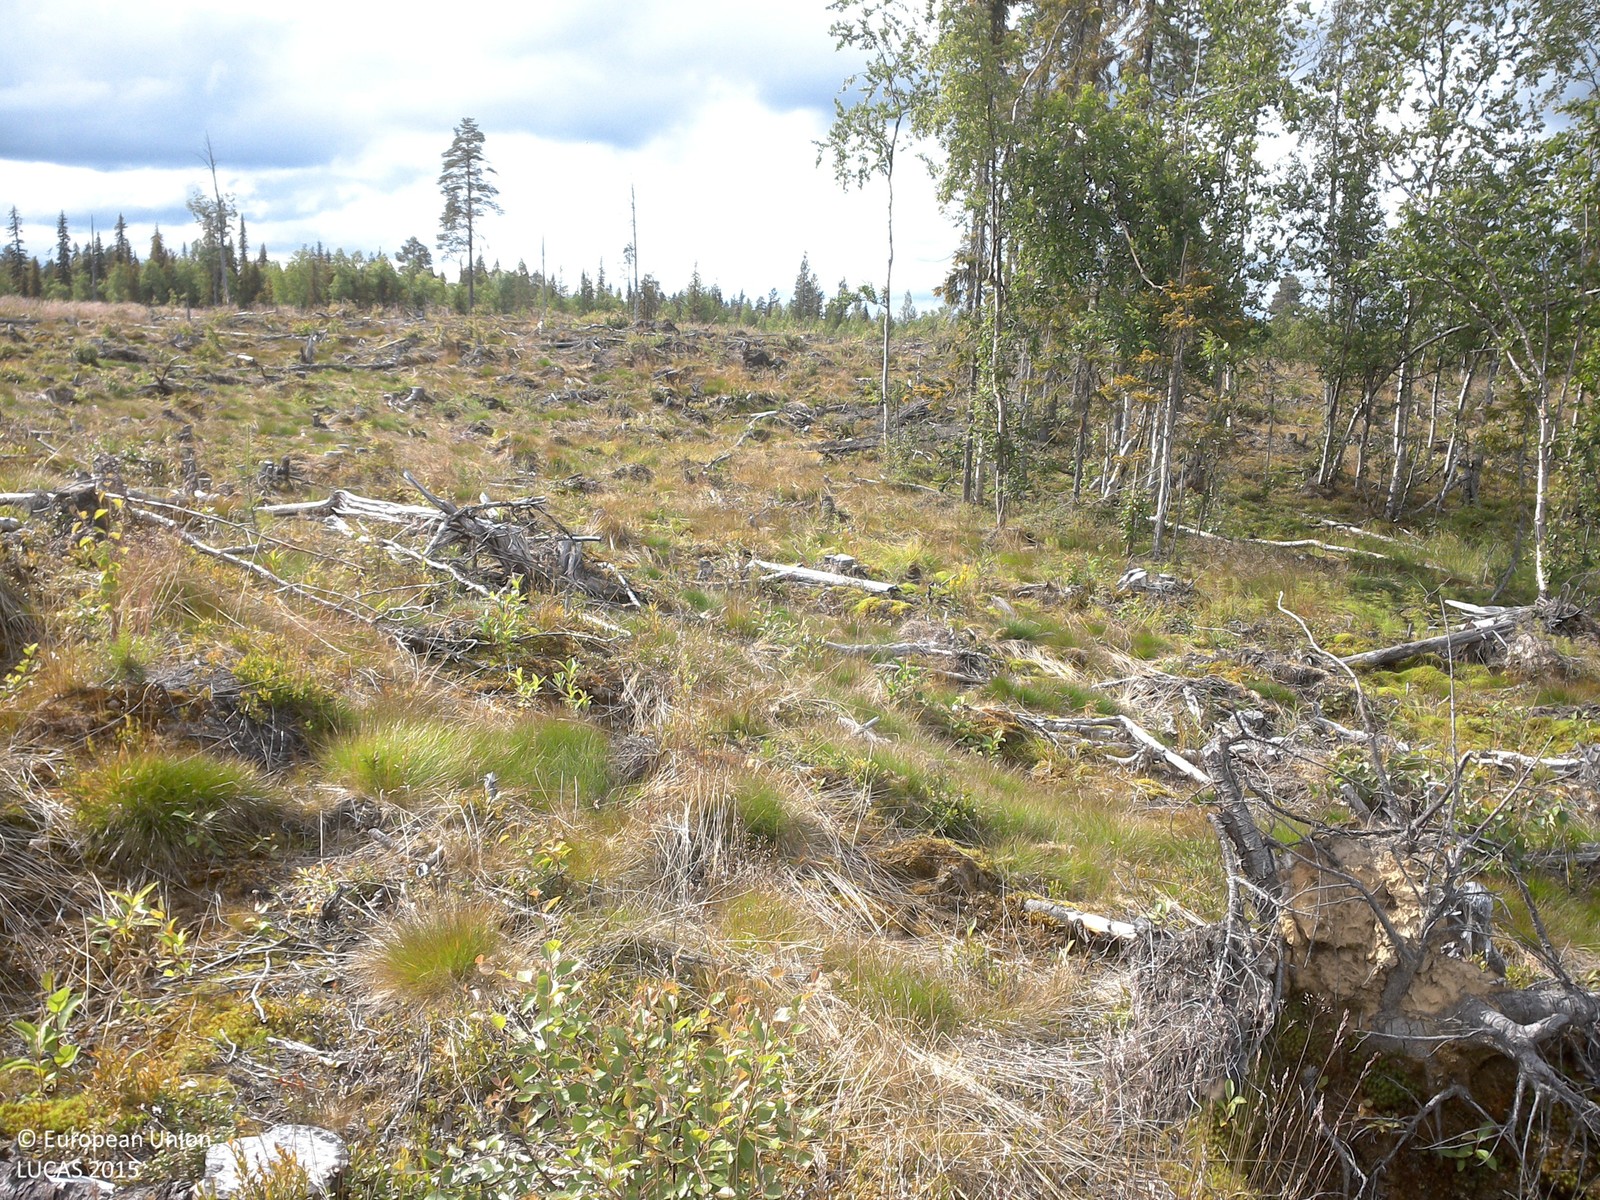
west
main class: Shrubland
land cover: Shrubland with sparse tree cover
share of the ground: 10 - 25 %
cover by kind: herbaceous plants 75 %, shrubs 10 %, unconsolidated bare surface 10 %, broadleaved forest trees 5 %
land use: Forestry
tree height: < 5 m
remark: Clear cut
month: July
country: SE
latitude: 67.5009
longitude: 22.2495
